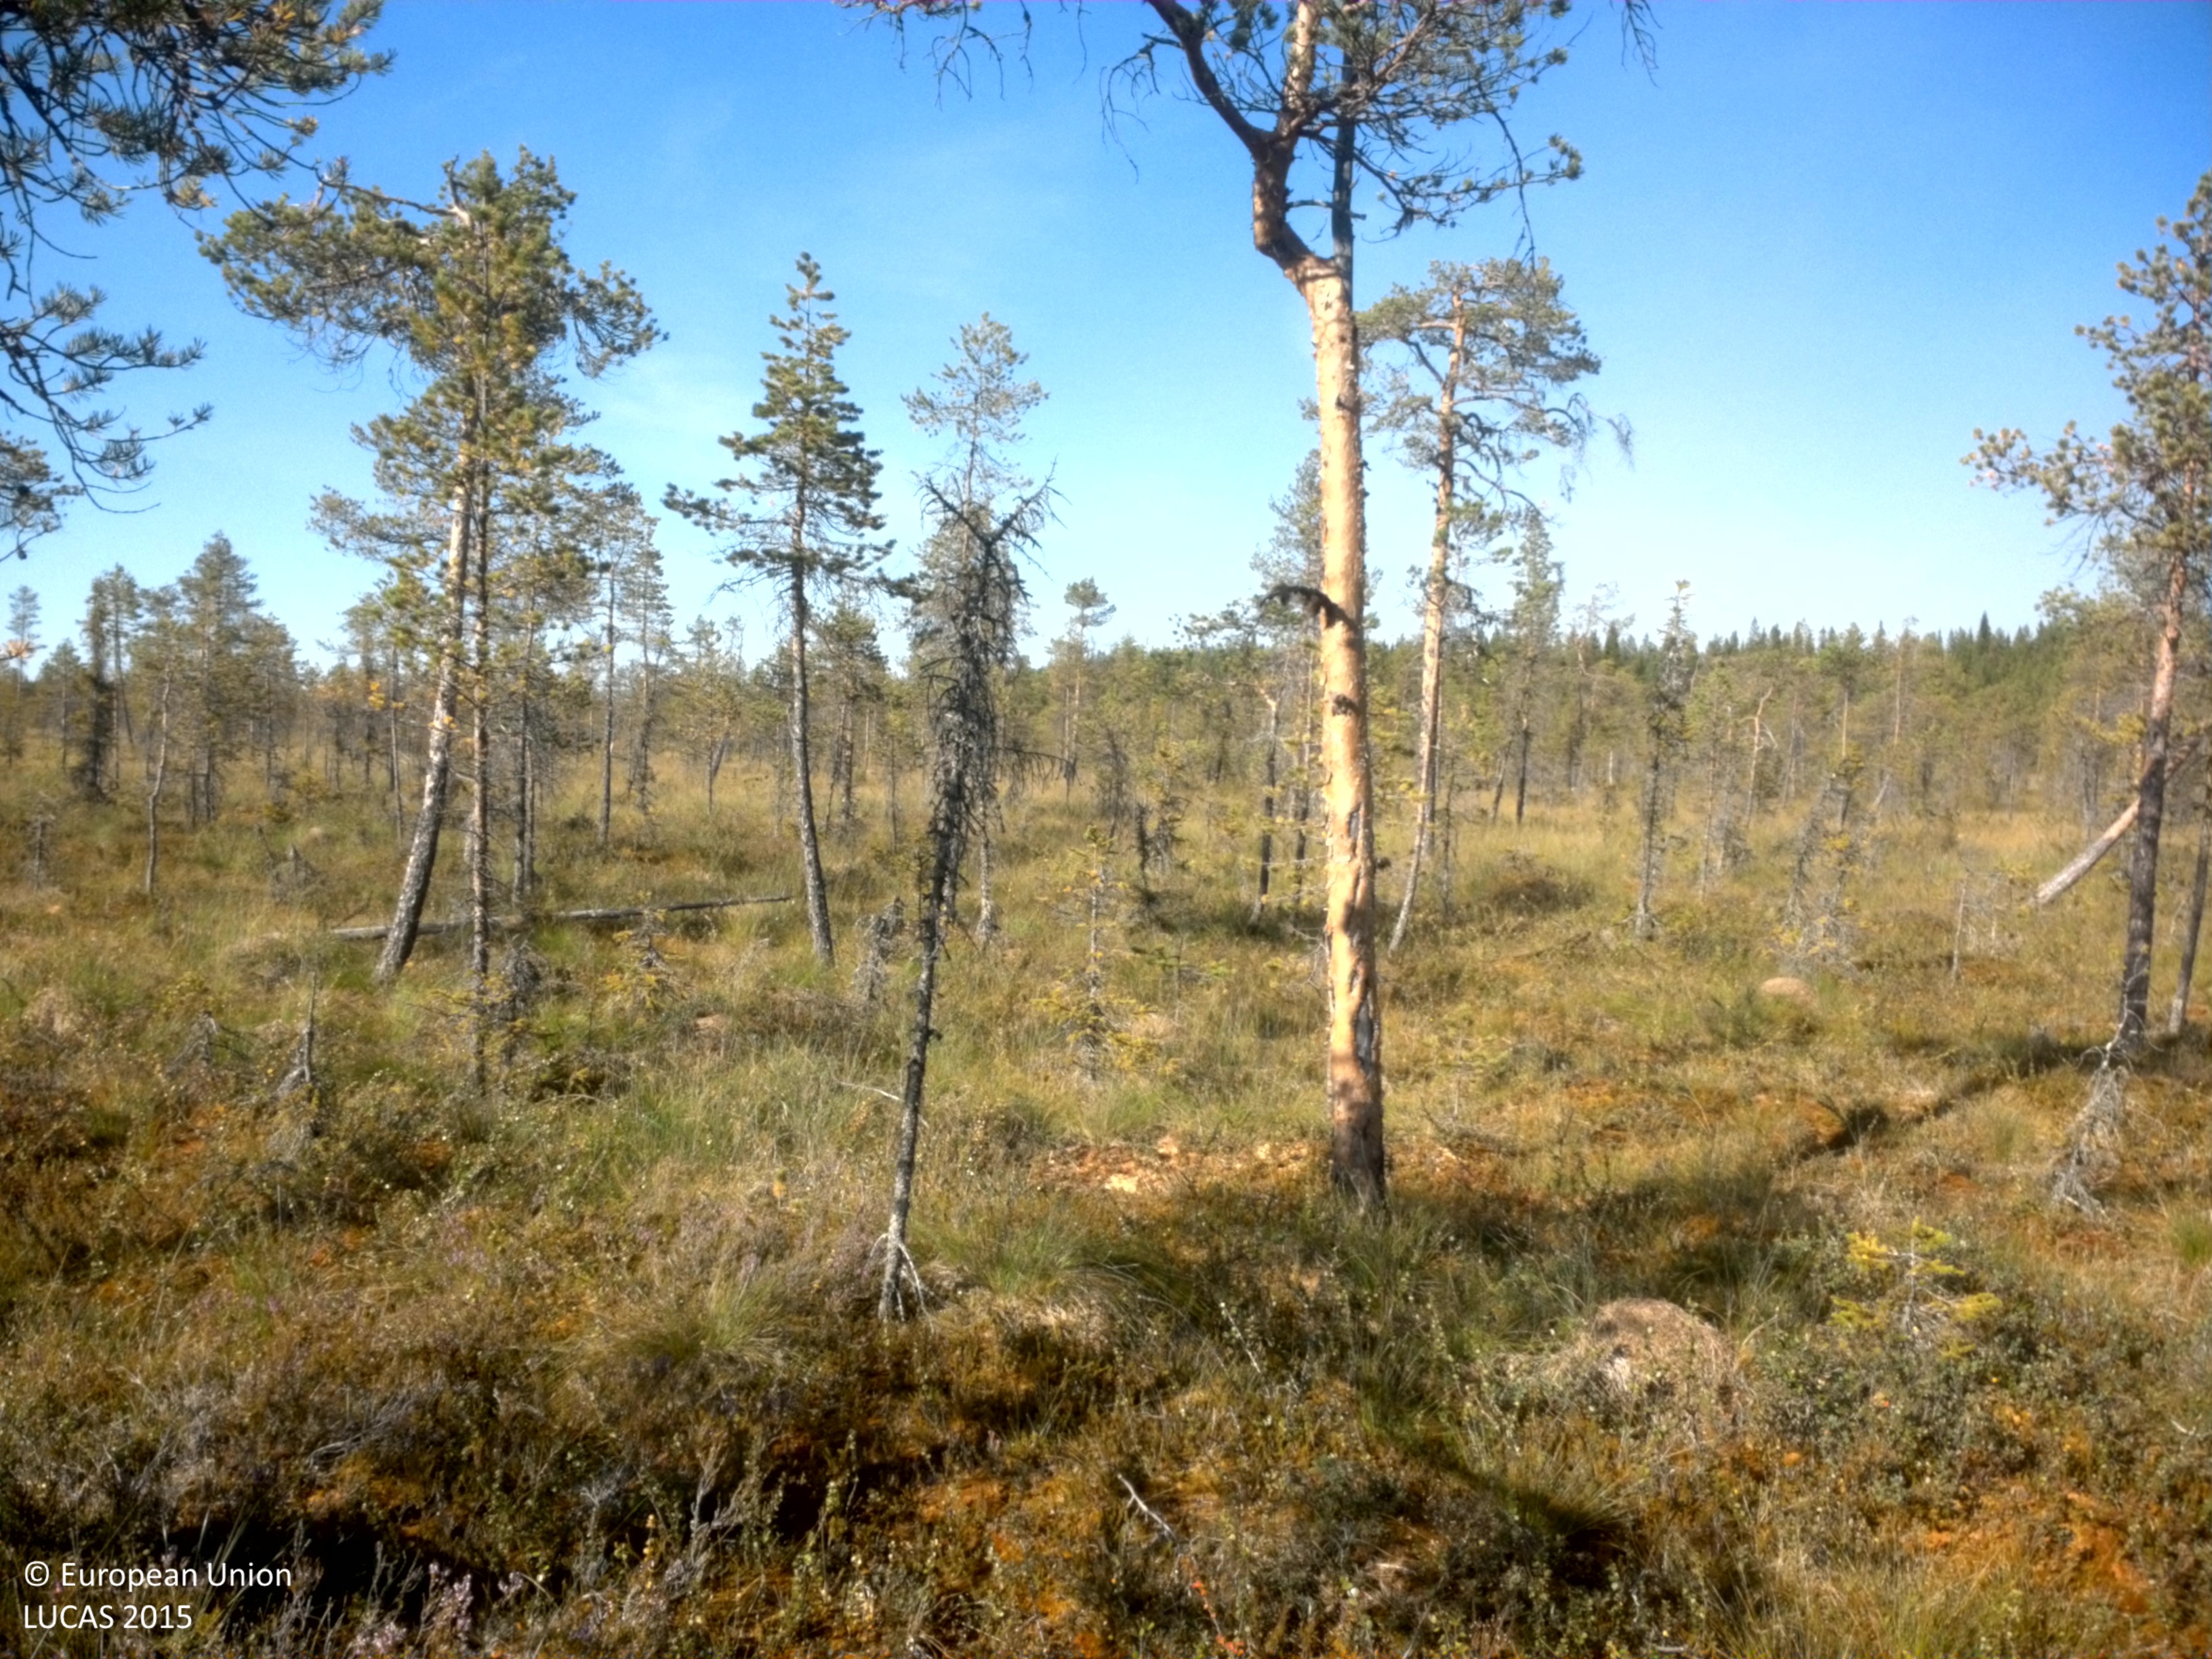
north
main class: Woodland
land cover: Pine dominated coniferous woodland
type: boreal forest
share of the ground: 25 - 50 %
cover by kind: coniferous forest trees 35 %, herbaceous plants 25 %, shrubs 20 %, lichens and mosses 20 %
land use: Semi-natural and natural areas not in use
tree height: > 5 m
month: August
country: SE
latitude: 64.5183
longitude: 18.4469
